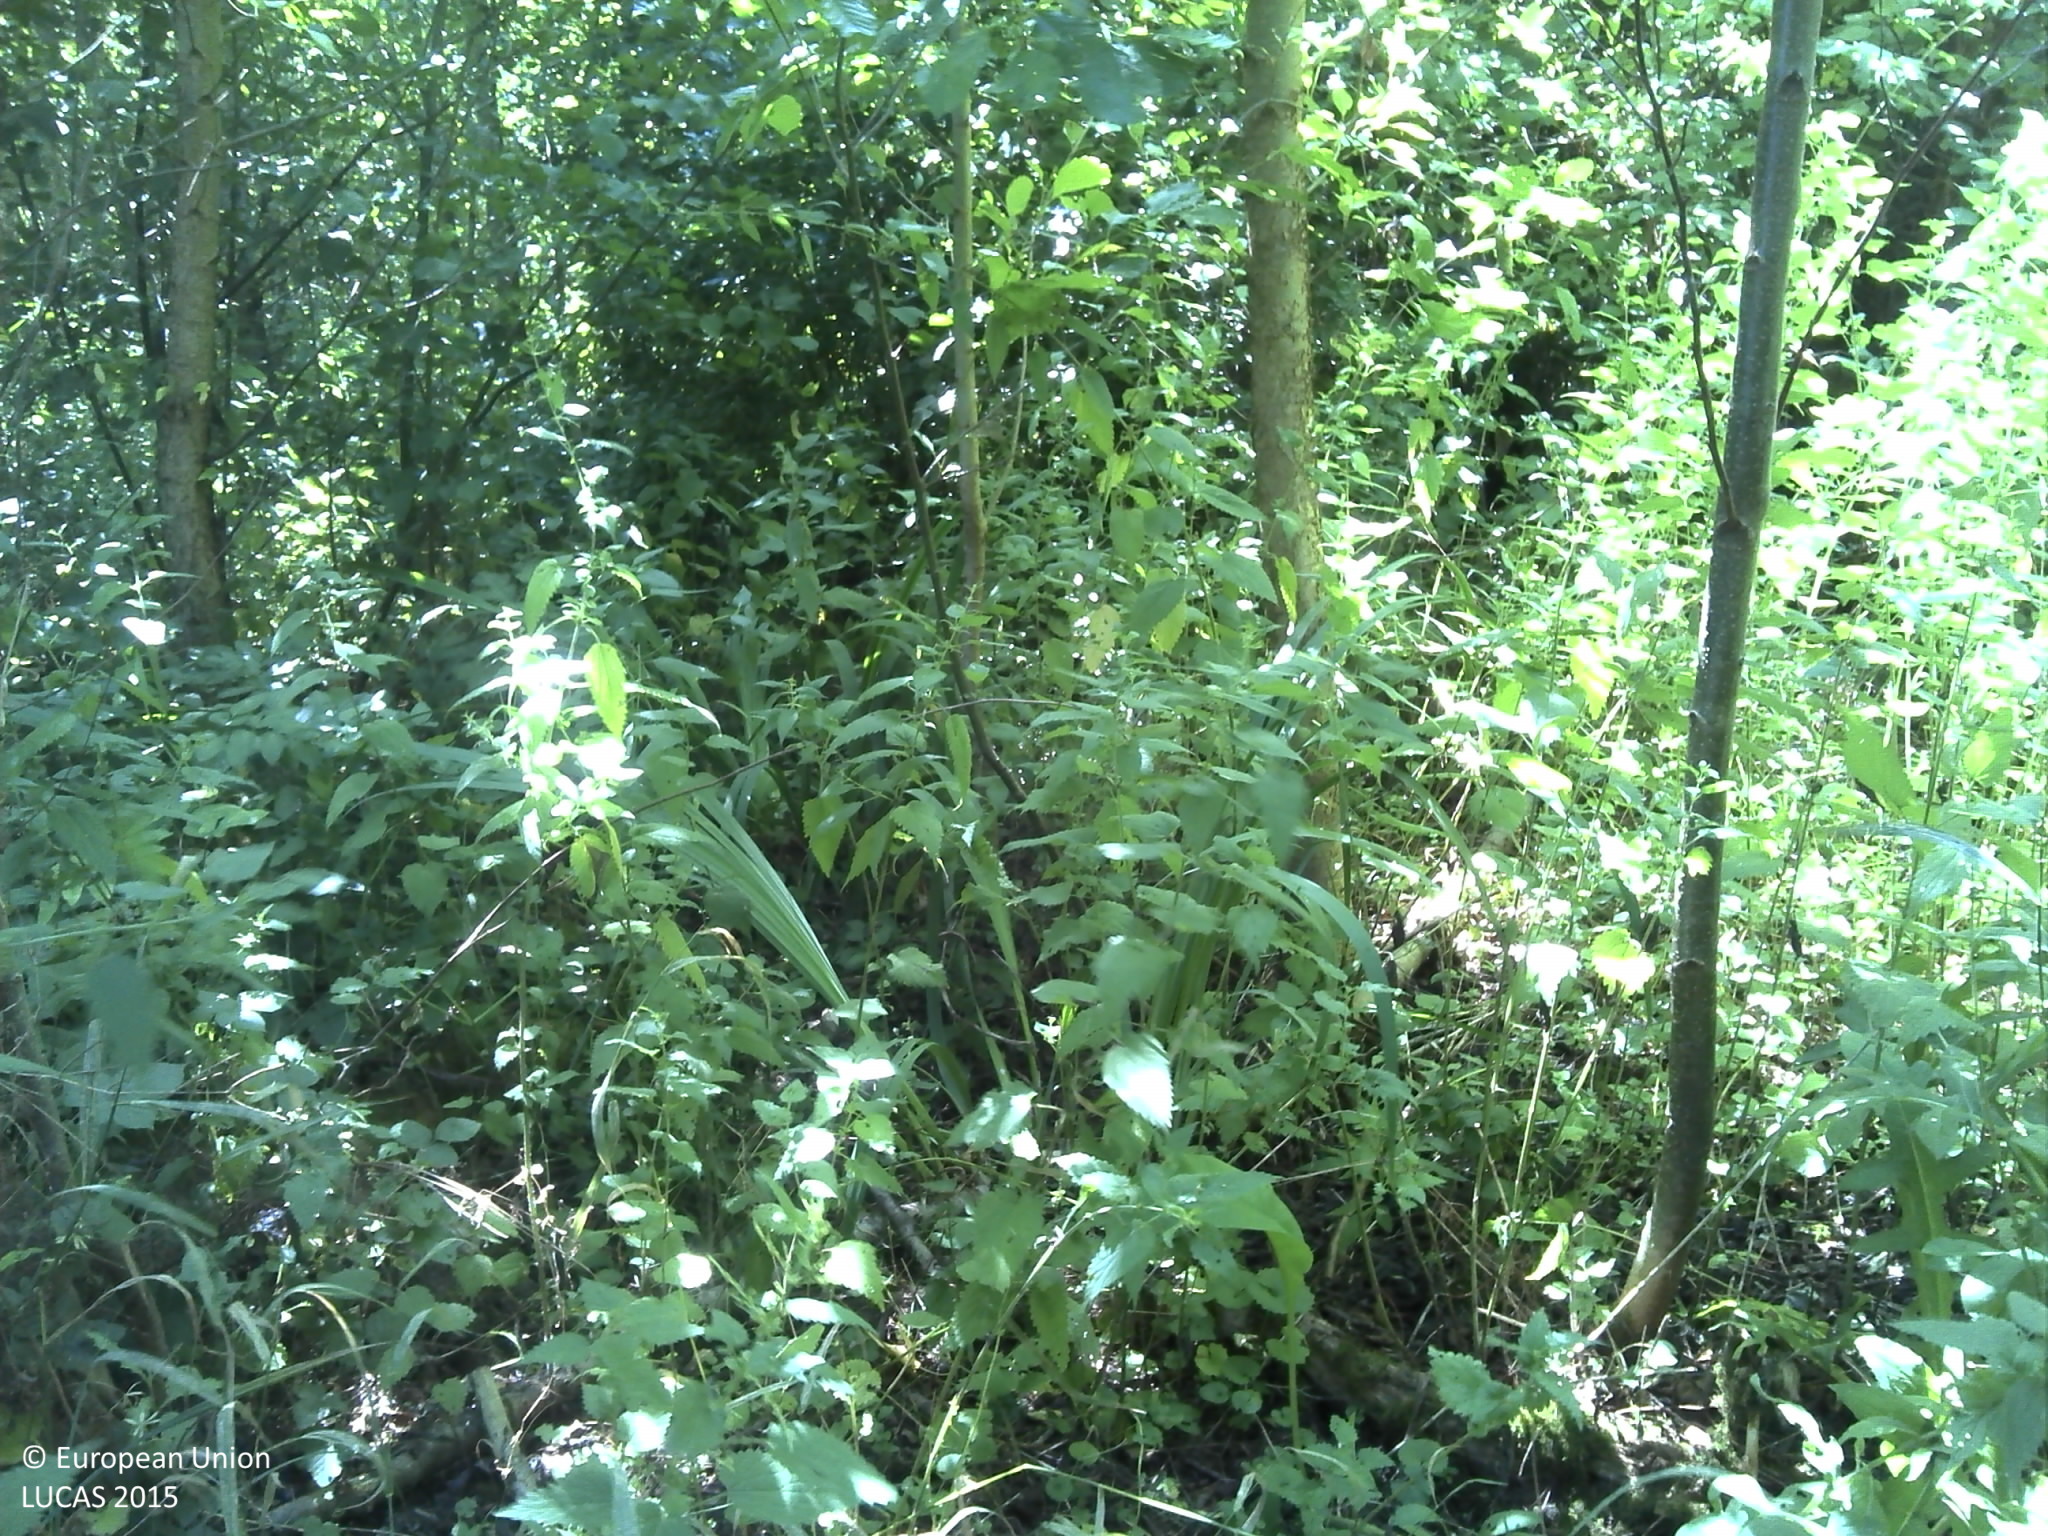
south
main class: Woodland
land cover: Broadleaved woodland
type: floodplain forest
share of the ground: > 75 %
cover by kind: broadleaved forest trees 70 %, herbaceous plants 20 %, shrubs 10 %
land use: Forestry
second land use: Amenities, museums, leisure
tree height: > 5 m
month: July
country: FR
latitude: 48.5260
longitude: 1.9566
